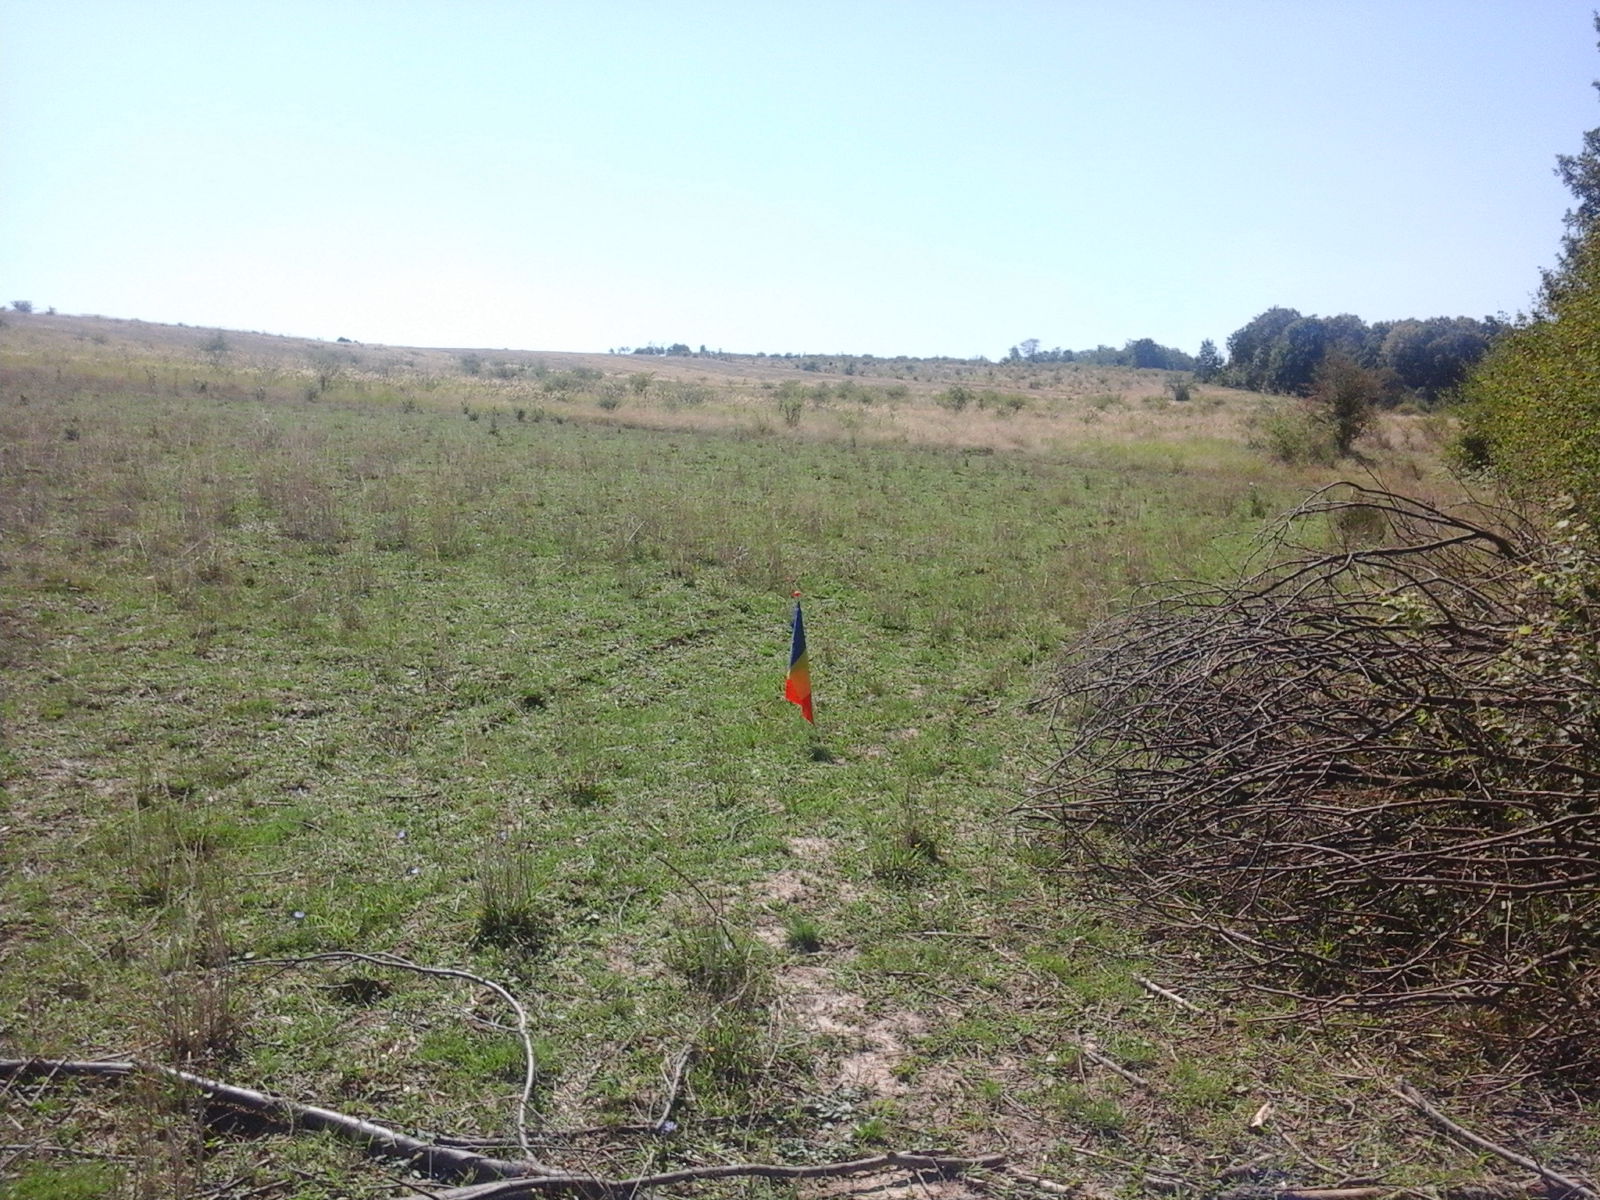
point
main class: Grassland
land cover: Grassland without tree/shrub cover
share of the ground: > 75 %
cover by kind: herbaceous plants 100 %
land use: Agriculture (excluding fallow land and kitchen gardens)
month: August
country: RO
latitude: 45.5988
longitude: 21.6886
